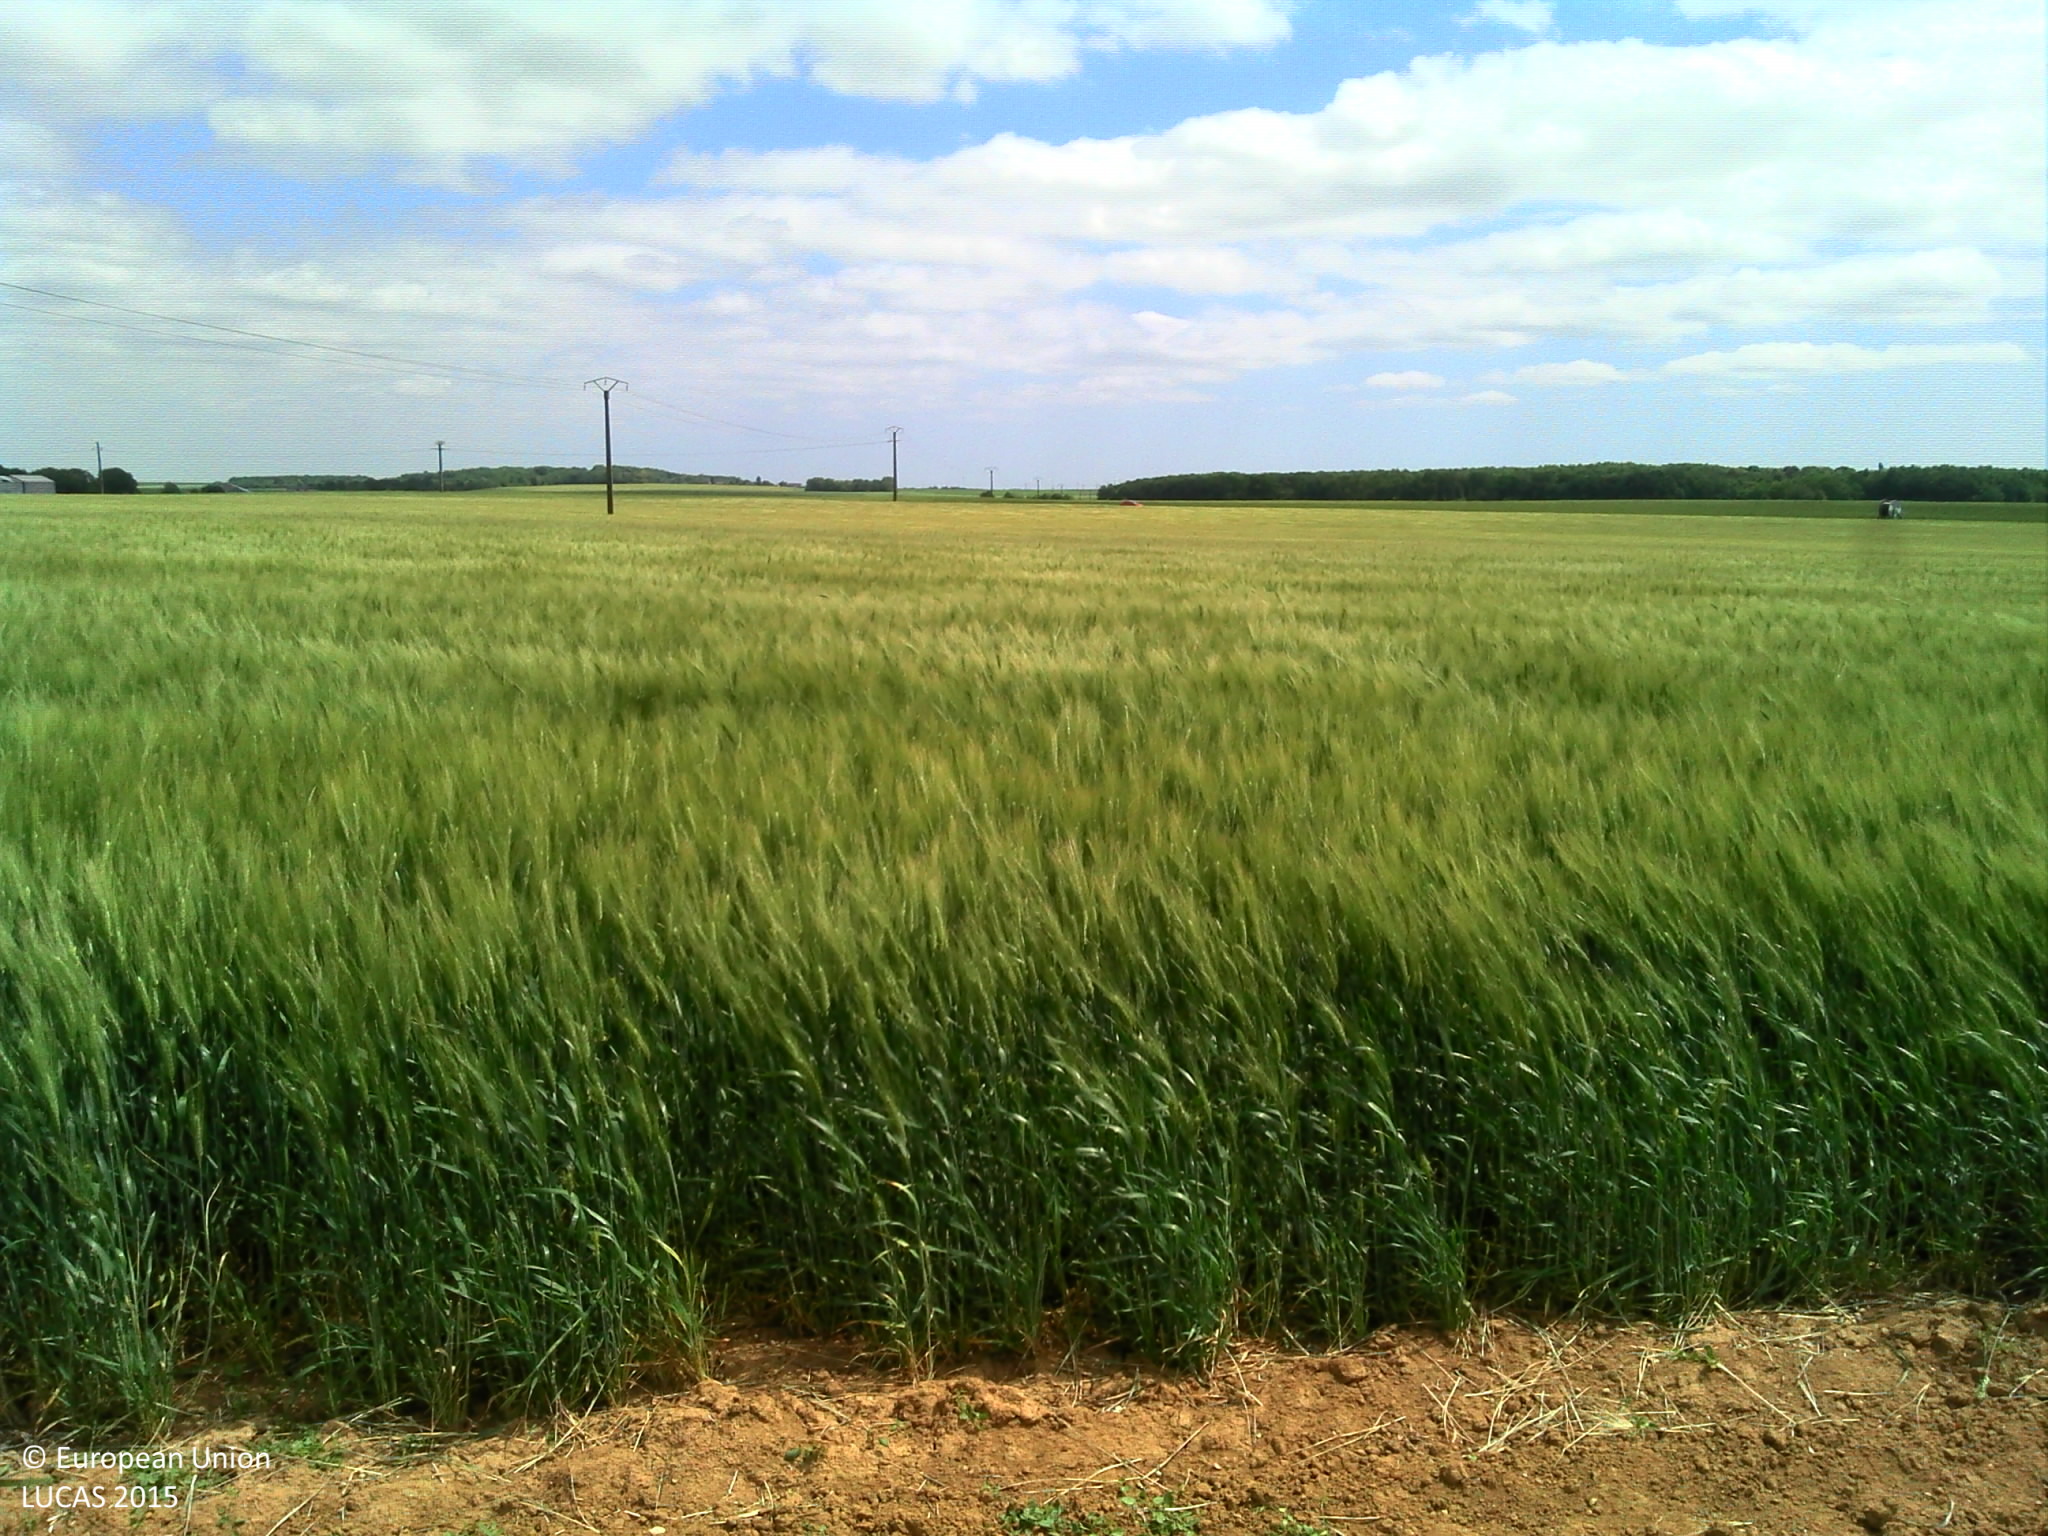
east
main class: Cropland
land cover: Maize
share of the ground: 25 - 50 %
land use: Agriculture (excluding fallow land and kitchen gardens)
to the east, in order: Maize; Barley
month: June
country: FR
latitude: 48.1284
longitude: 1.4791
